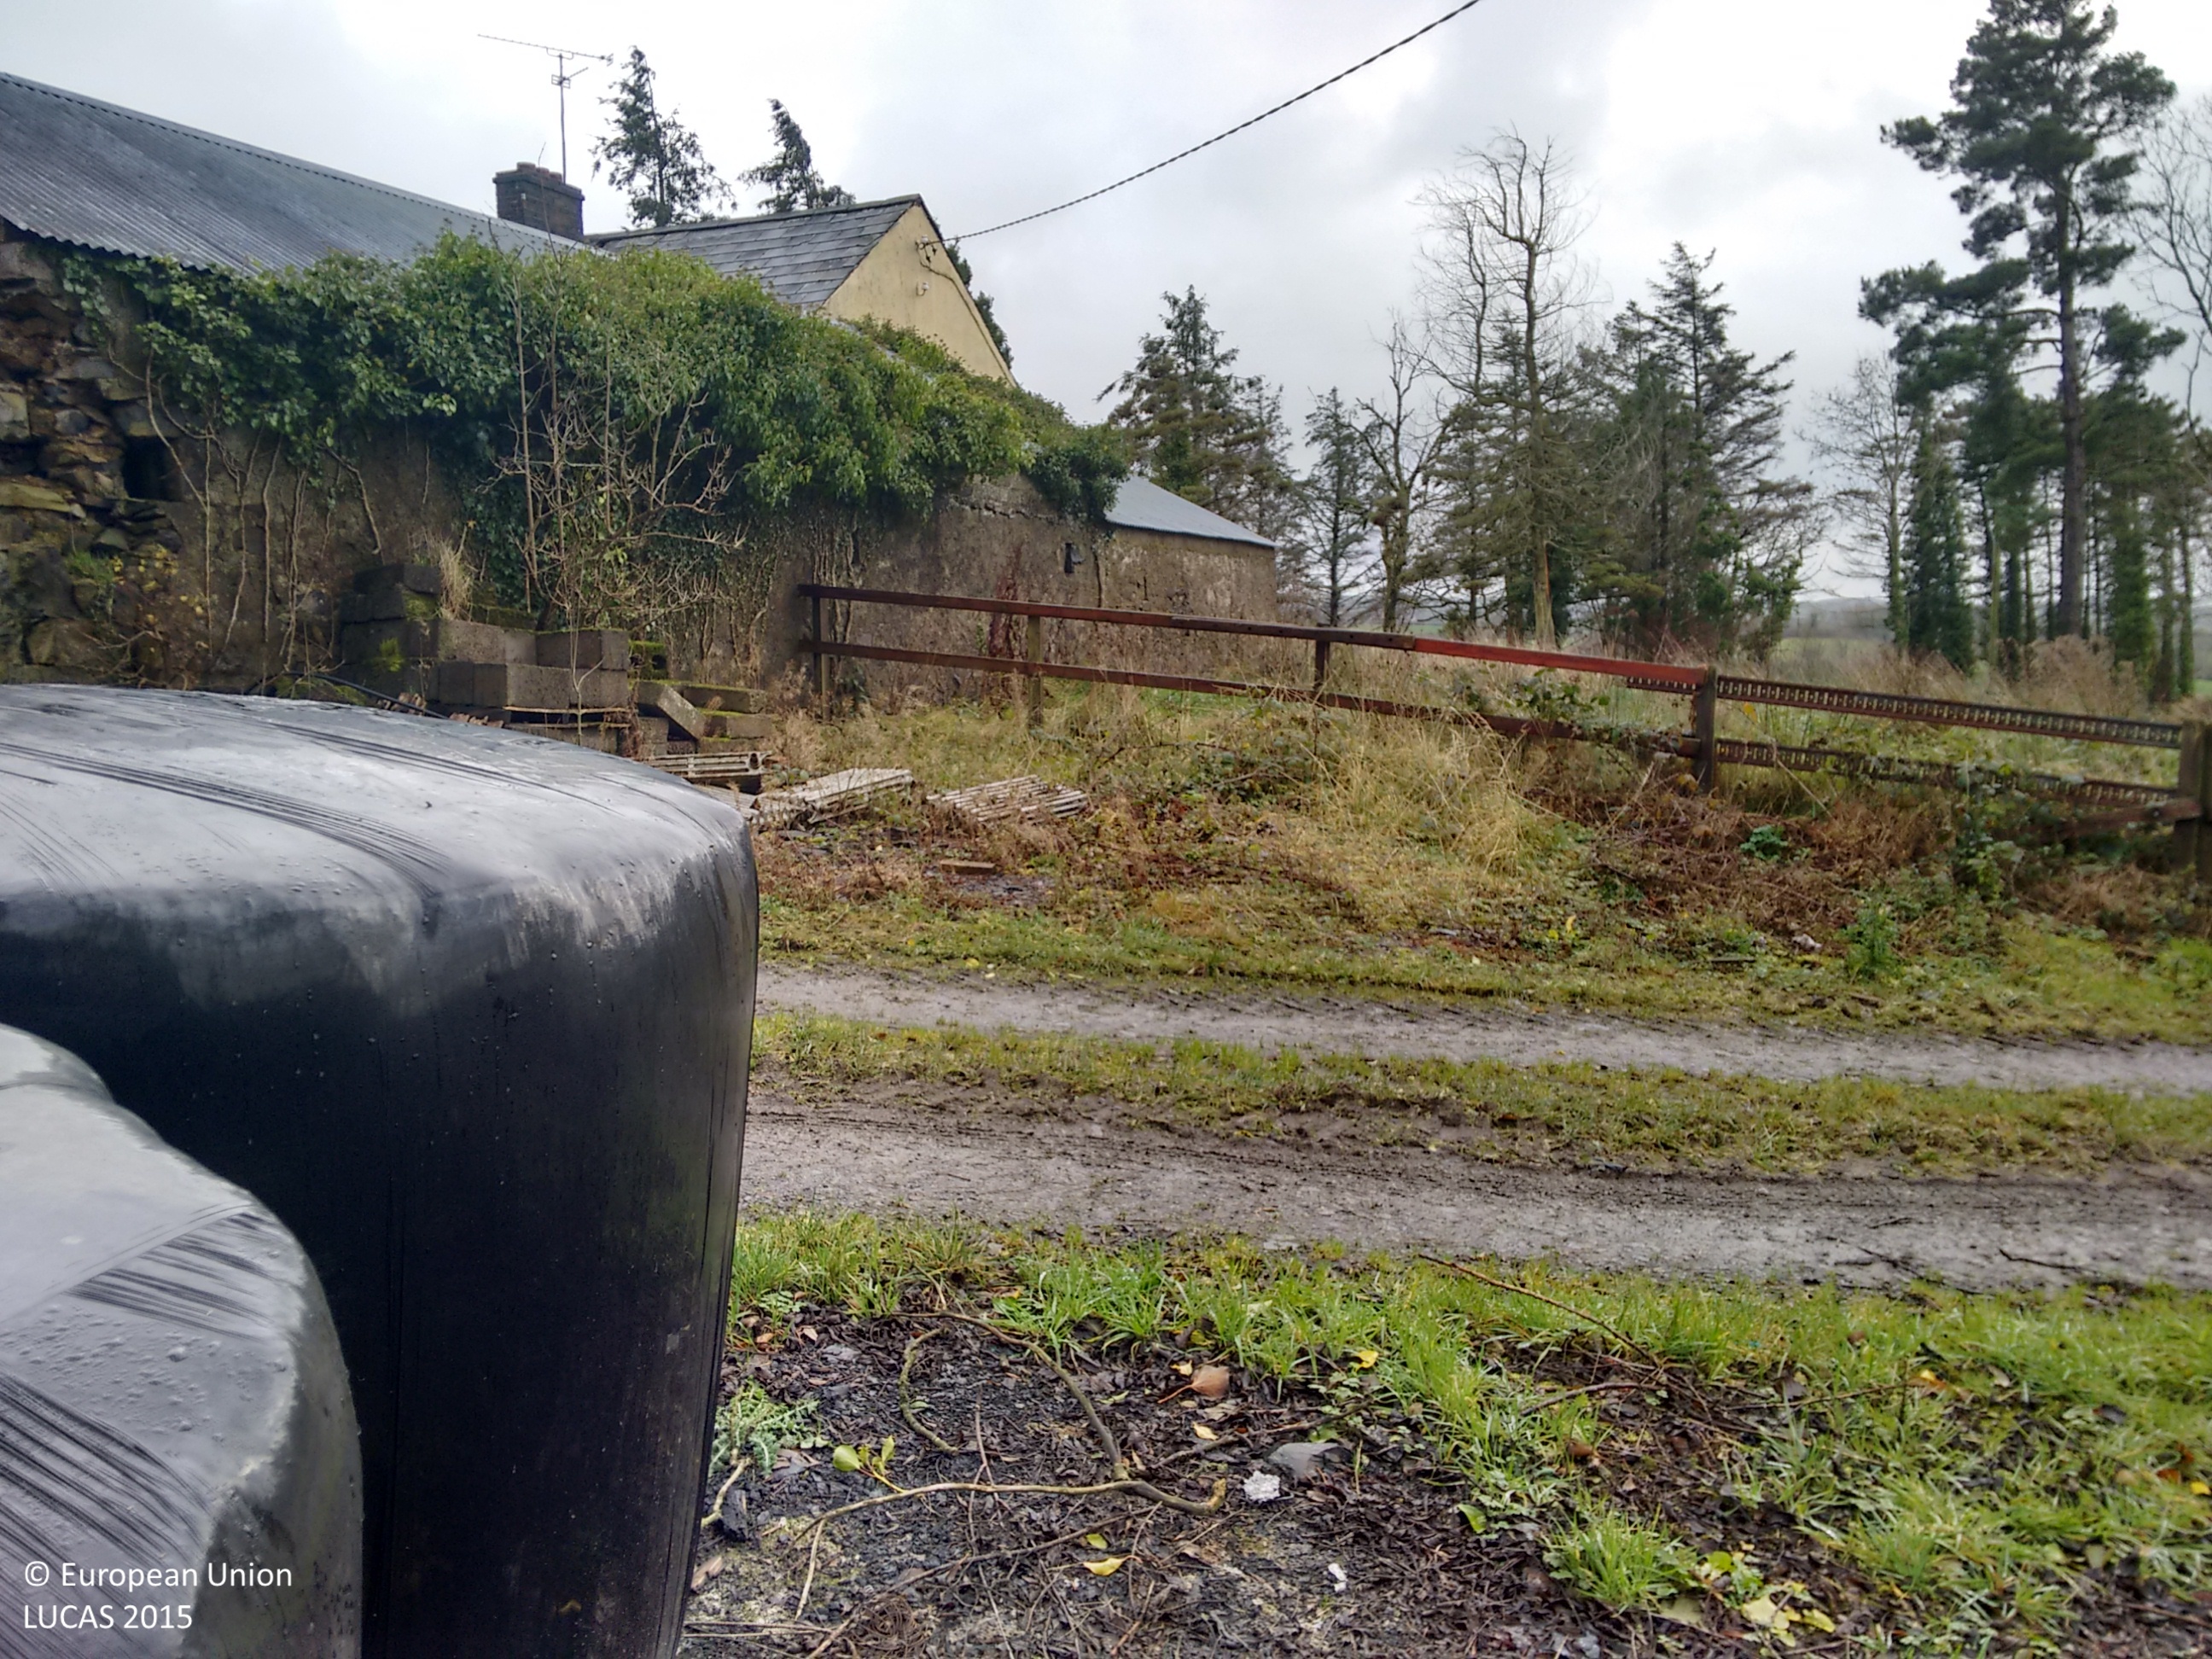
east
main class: Grassland
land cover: Grassland without tree/shrub cover
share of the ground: > 75 %
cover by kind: herbaceous plants 100 %
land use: Agriculture (excluding fallow land and kitchen gardens)
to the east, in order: Grassland without tree/shrub cover; Fences; Abandoned hedges; Shruby margins; Grassland without tree/shrub cover; Artificial constructions in urban areas; Ditches and canals; Abandoned hedges; Grassland without tree/shrub cover; Abandoned hedges; Grassland without tree/shrub cover
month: December
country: IE
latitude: 54.0139
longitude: -7.2248
